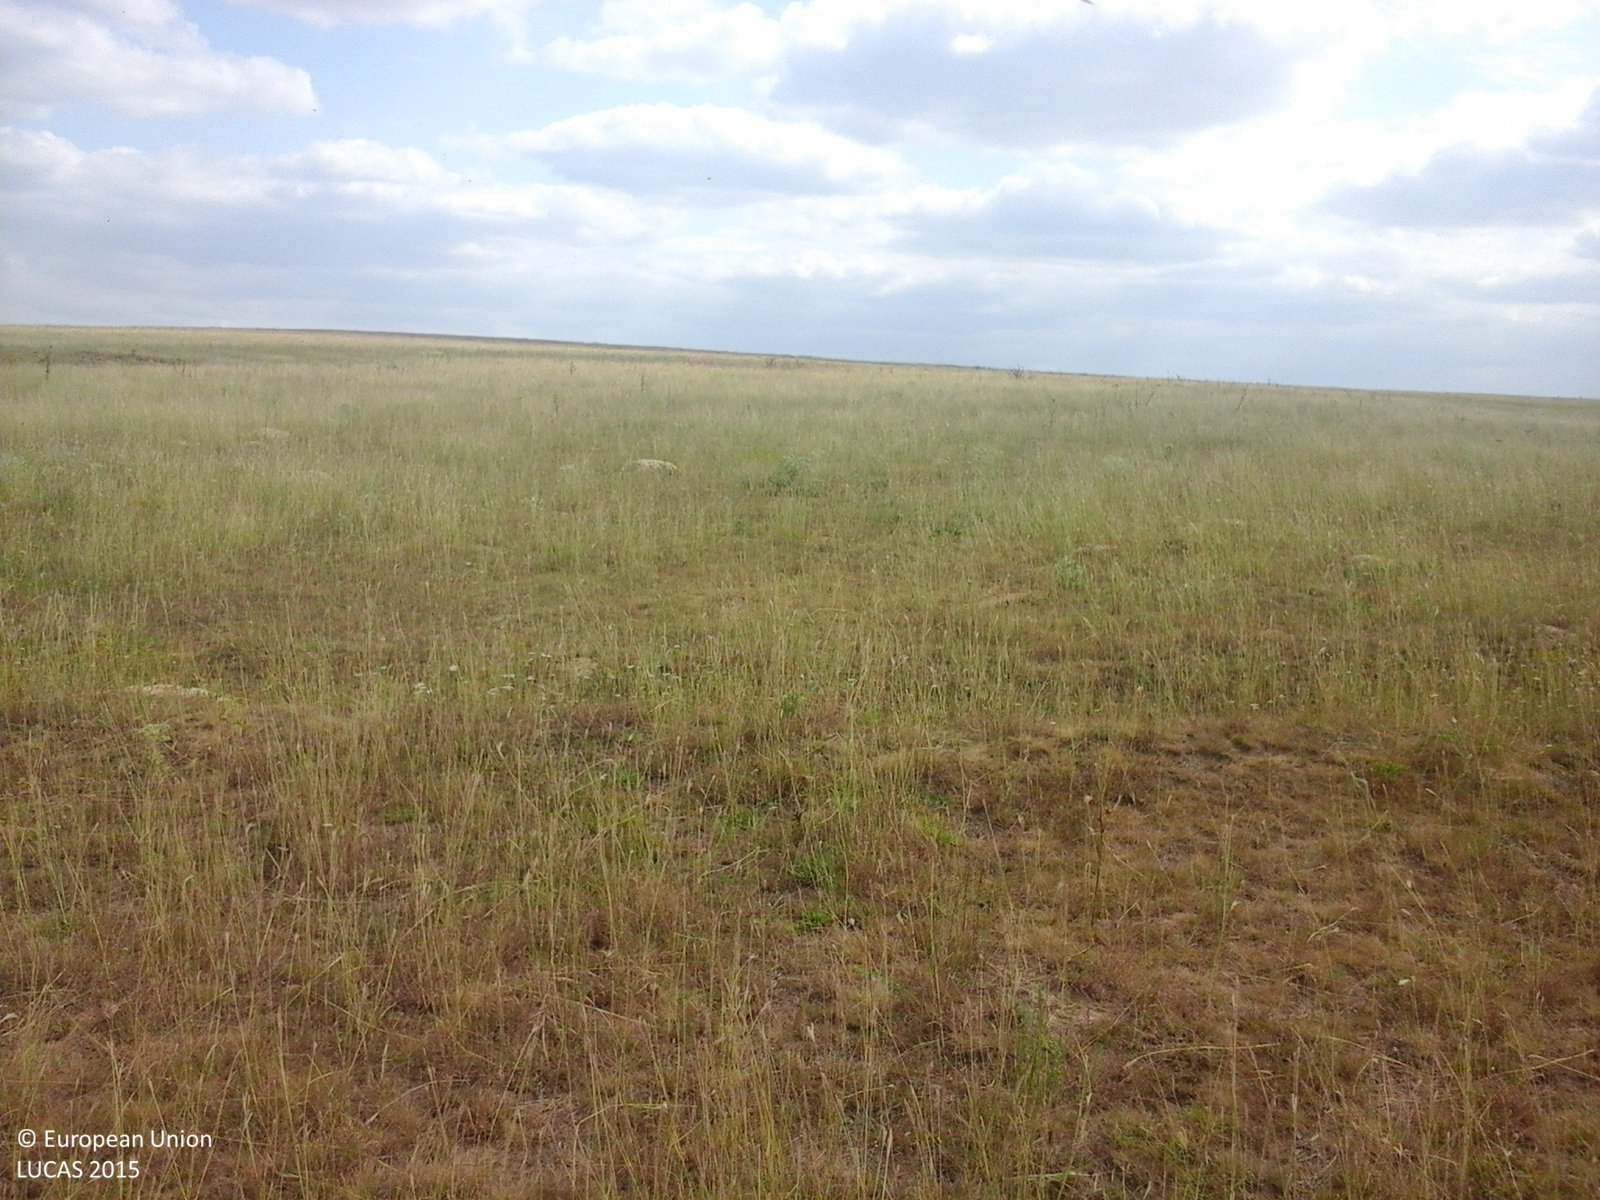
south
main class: Grassland
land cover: Grassland without tree/shrub cover
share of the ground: > 75 %
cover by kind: herbaceous plants 100 %
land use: Agriculture (excluding fallow land and kitchen gardens)
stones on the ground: < 10 %
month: August
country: RO
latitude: 44.7205
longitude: 28.1815
